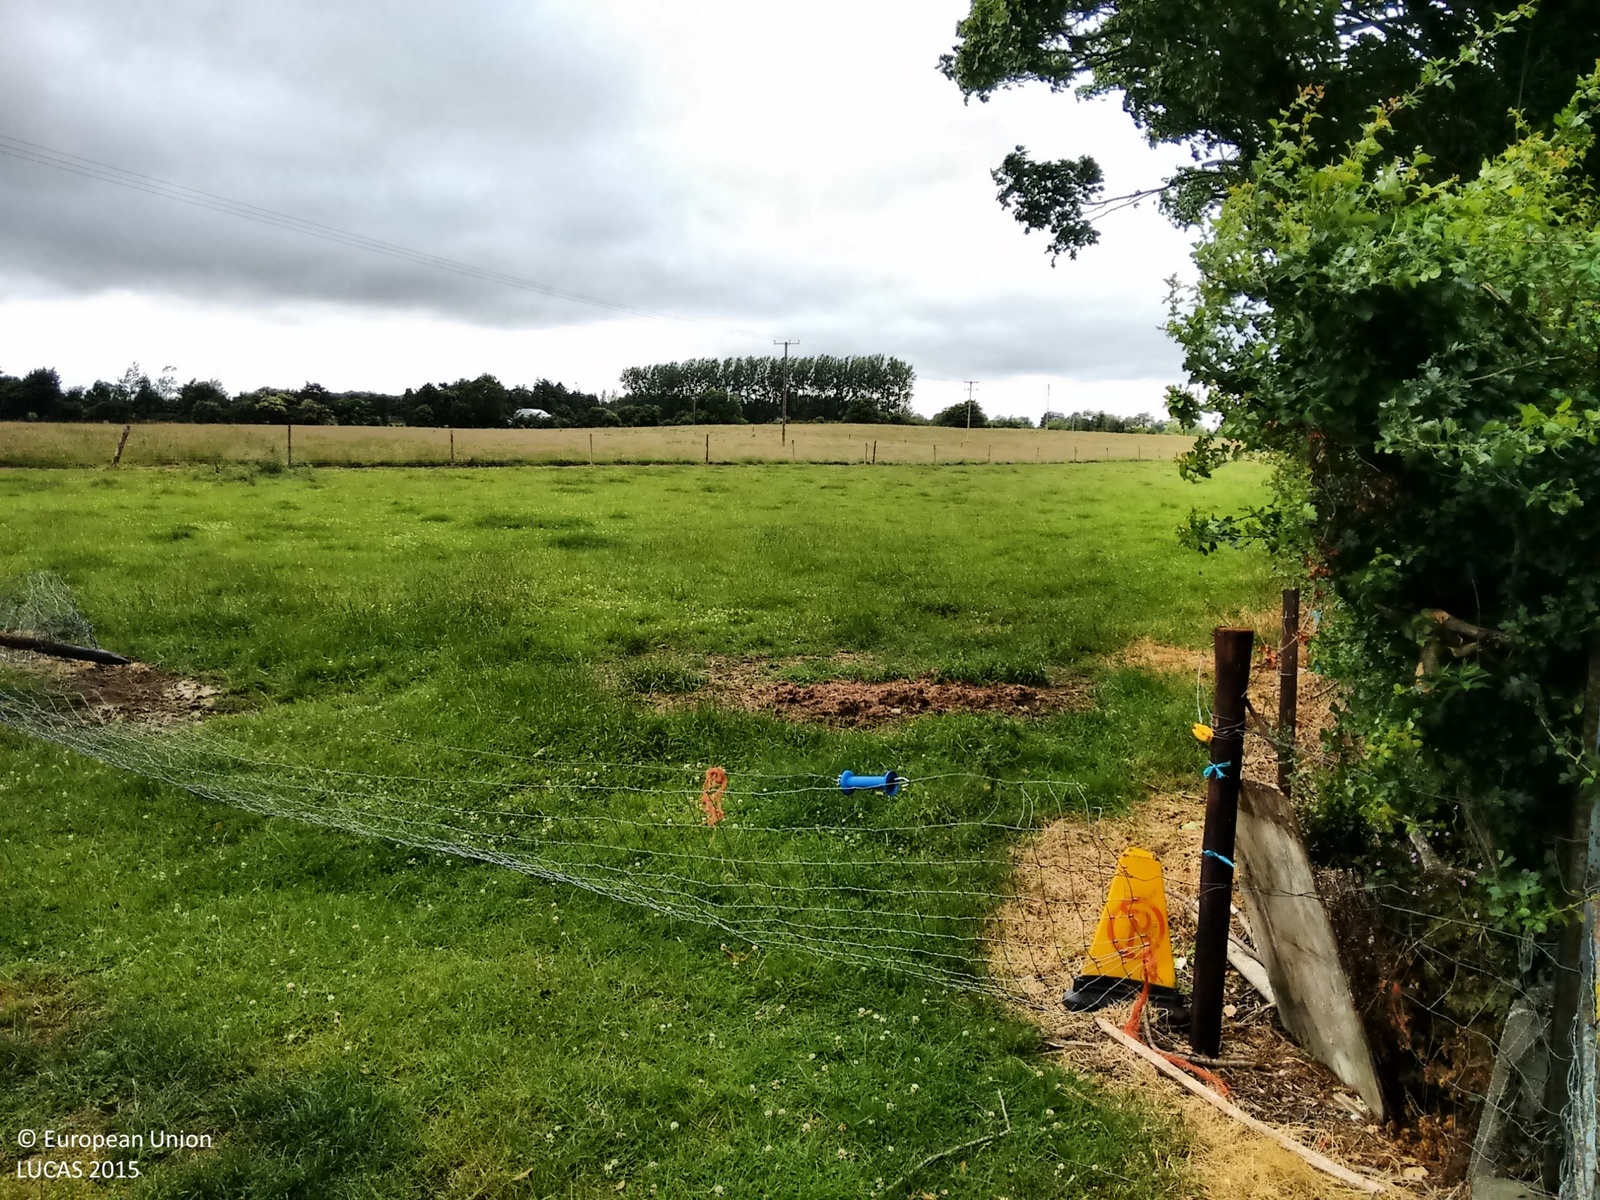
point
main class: Grassland
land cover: Grassland without tree/shrub cover
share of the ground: > 75 %
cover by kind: herbaceous plants 100 %
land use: Agriculture (excluding fallow land and kitchen gardens)
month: July
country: IE
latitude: 53.3339
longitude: -6.6963
